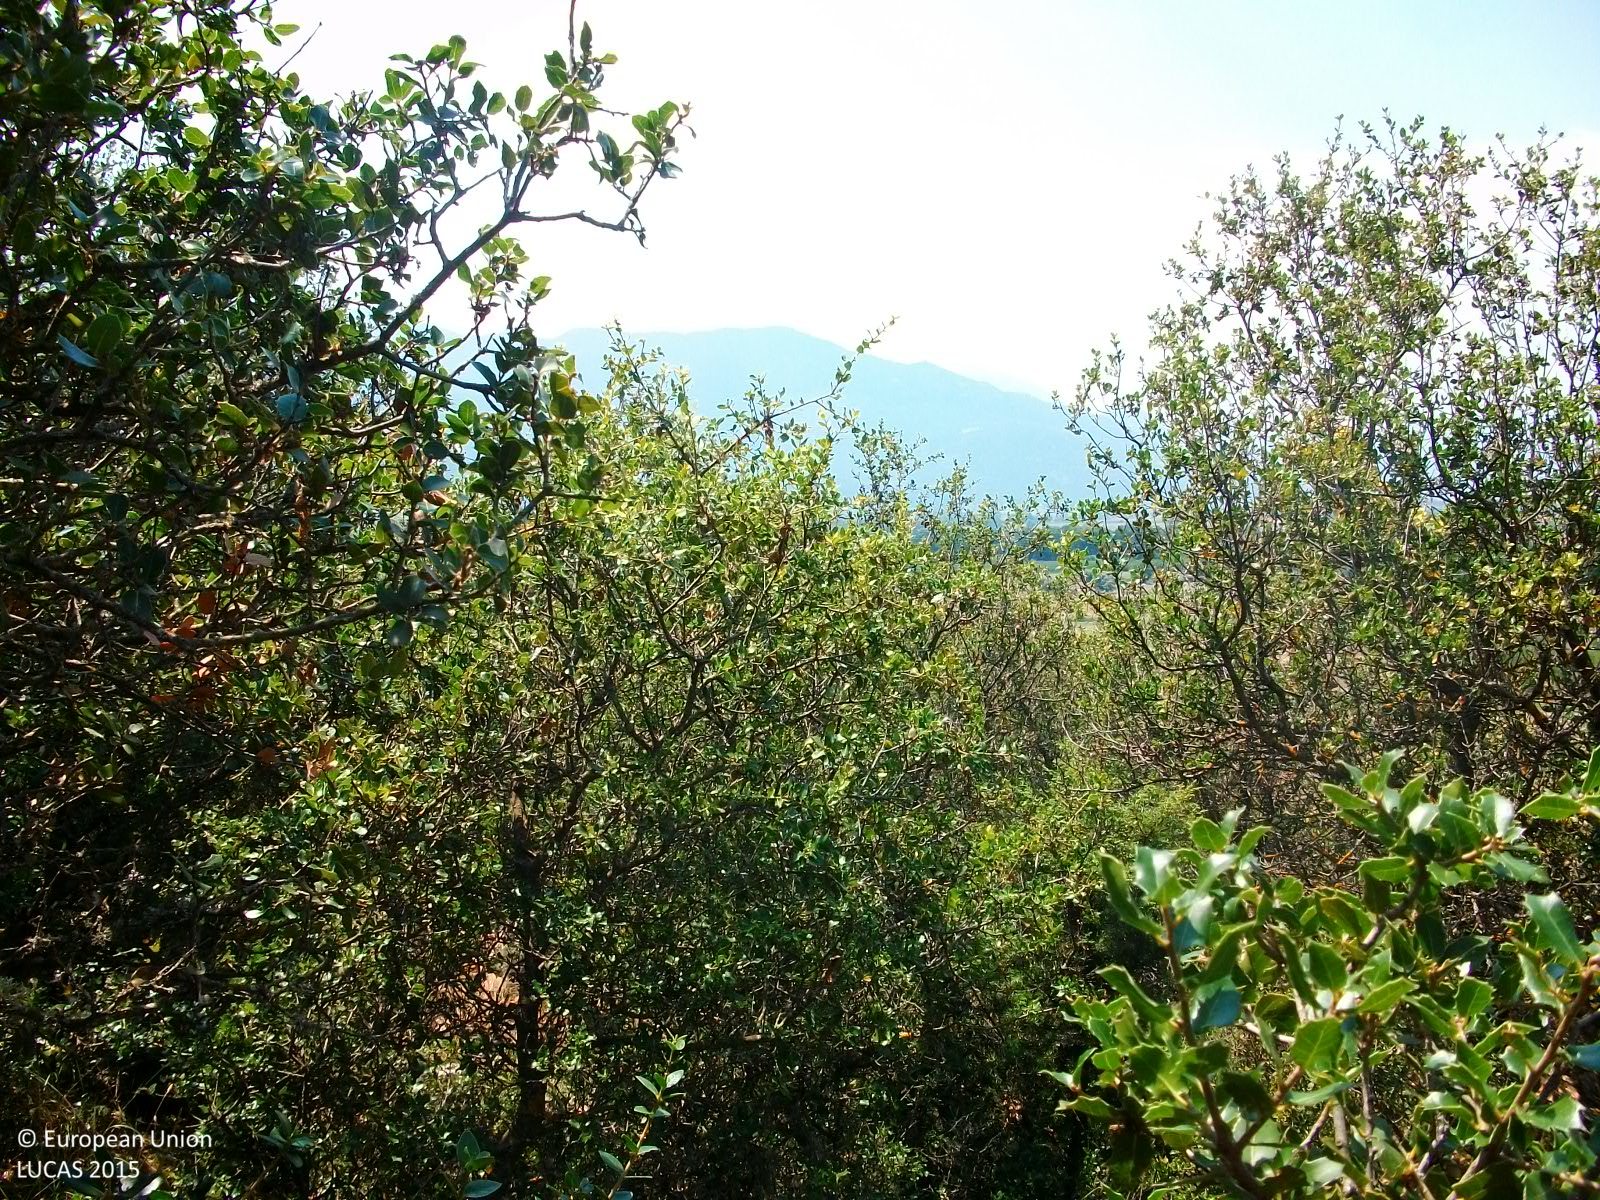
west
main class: Shrubland
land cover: Shrubland with sparse tree cover
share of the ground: > 75 %
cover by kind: shrubs 85 %, broadleaved forest trees 5 %, herbaceous plants 5 %, unconsolidated bare surface 5 %
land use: Agriculture (excluding fallow land and kitchen gardens)
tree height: < 5 m
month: July
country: GR
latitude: 38.6545
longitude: 22.5381
